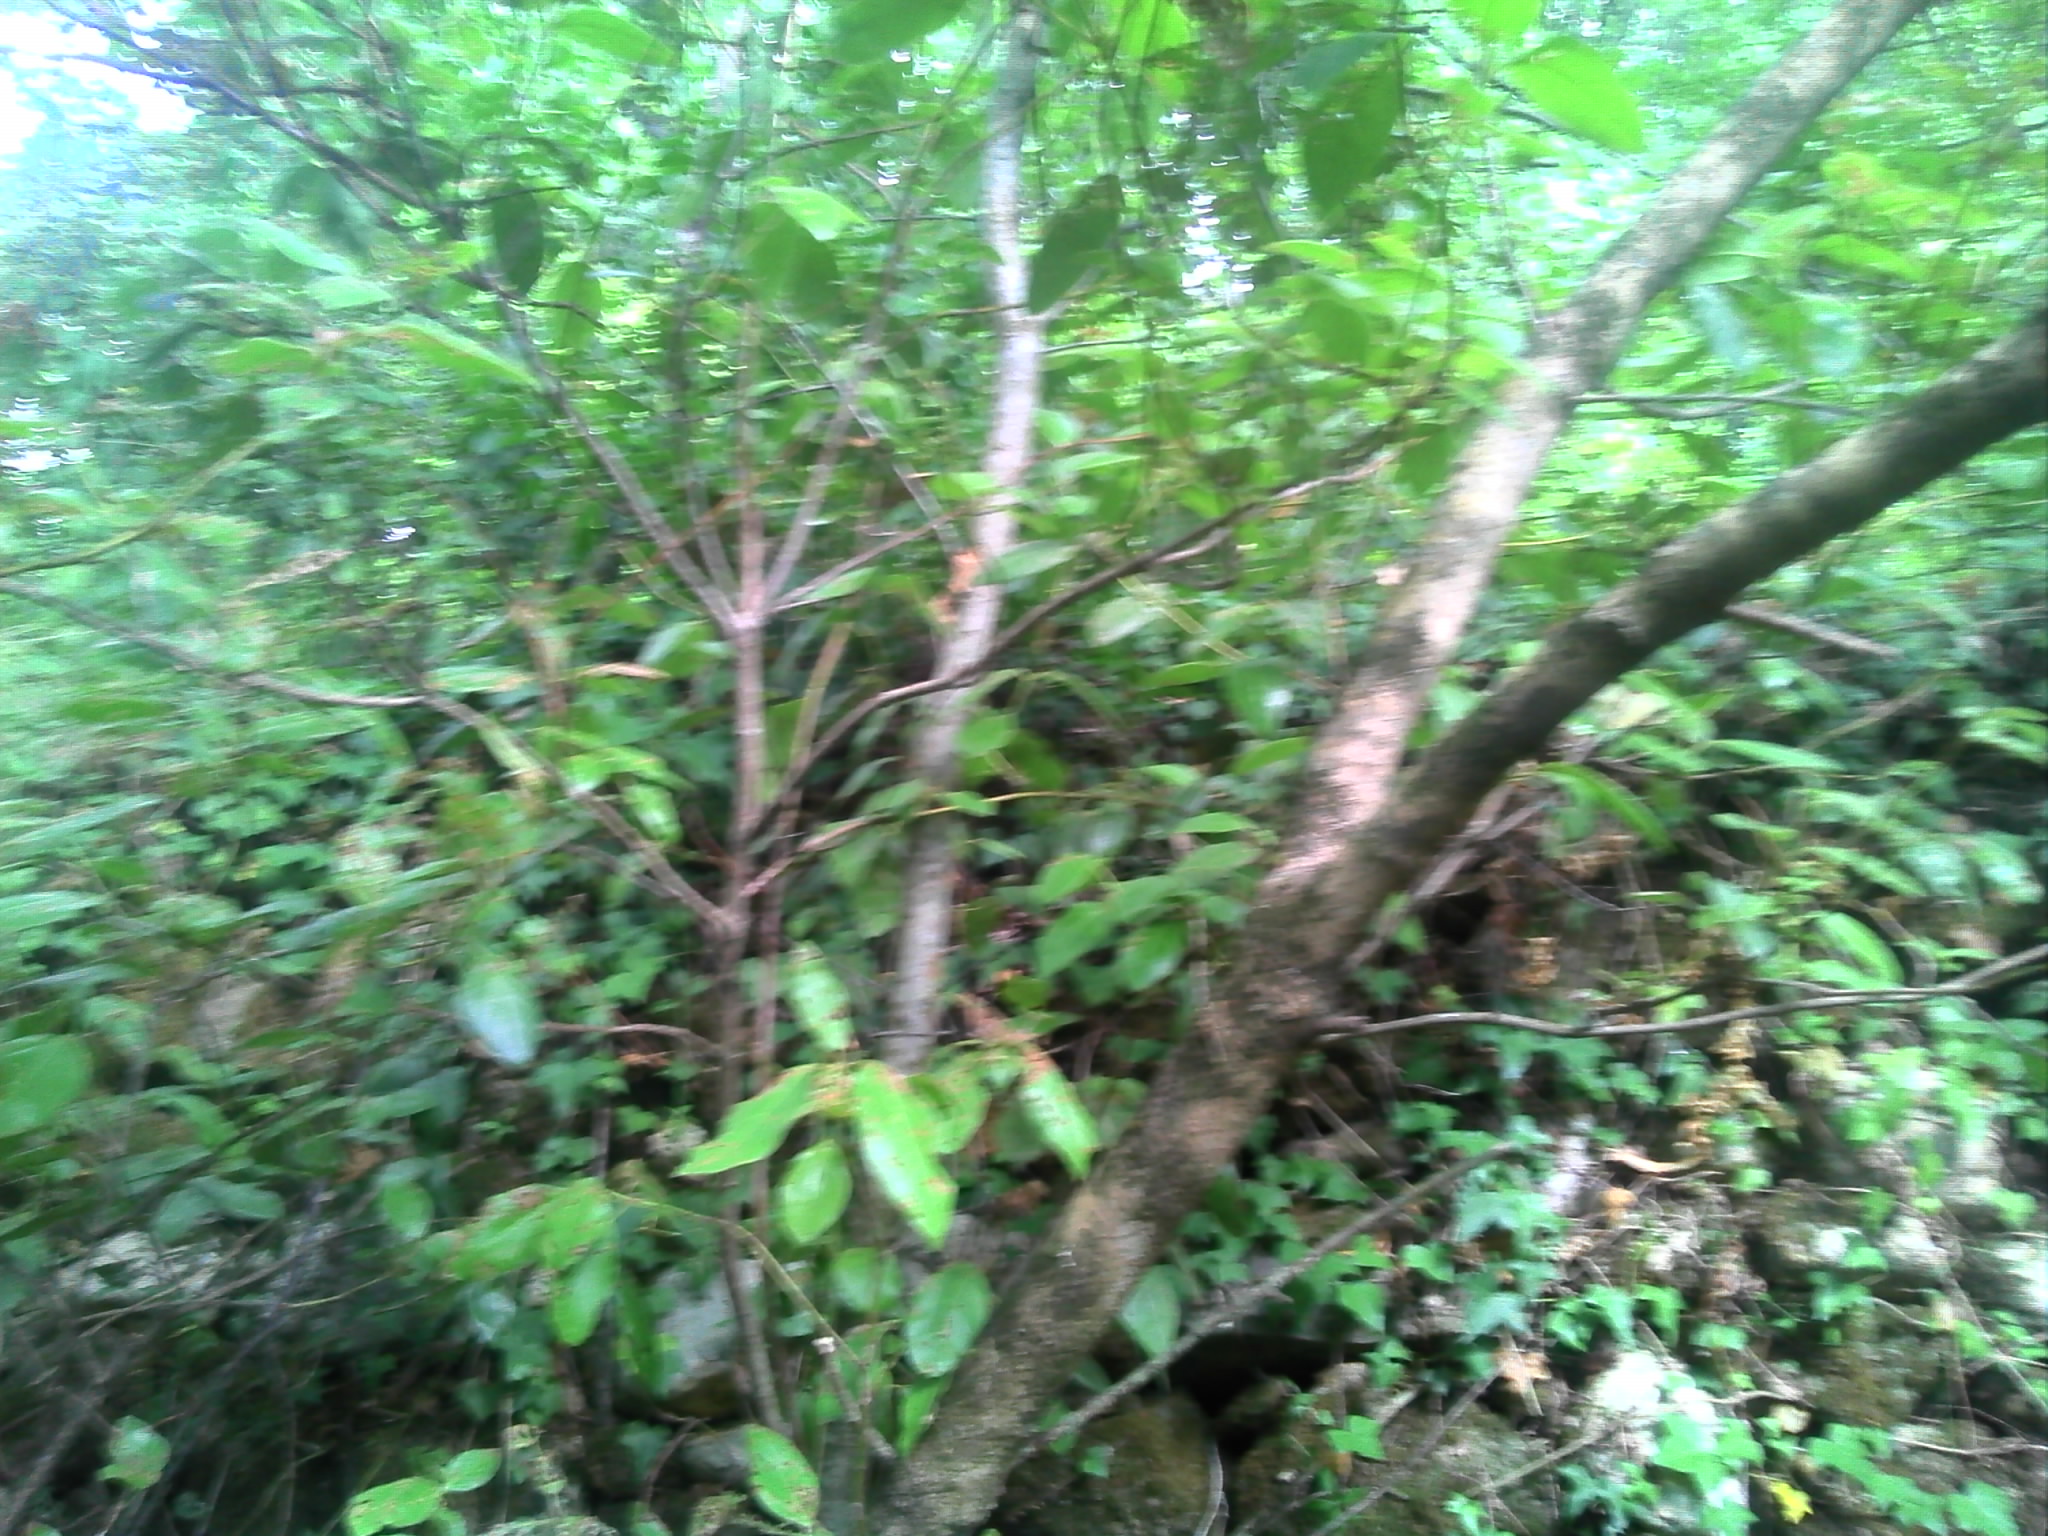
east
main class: Woodland
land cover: Broadleaved woodland
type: mesophytic deciduous forest
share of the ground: > 75 %
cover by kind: broadleaved forest trees 80 %, herbaceous plants 10 %, consolidated bare surface 10 %
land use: Forestry
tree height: > 5 m
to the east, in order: Broadleaved woodland; Grass margins; Paved roads, cycling and walking lanes; Grass margins; Electric lines; Rock outcrops; Broadleaved woodland
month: July
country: FR
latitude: 44.1016
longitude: 3.9487
